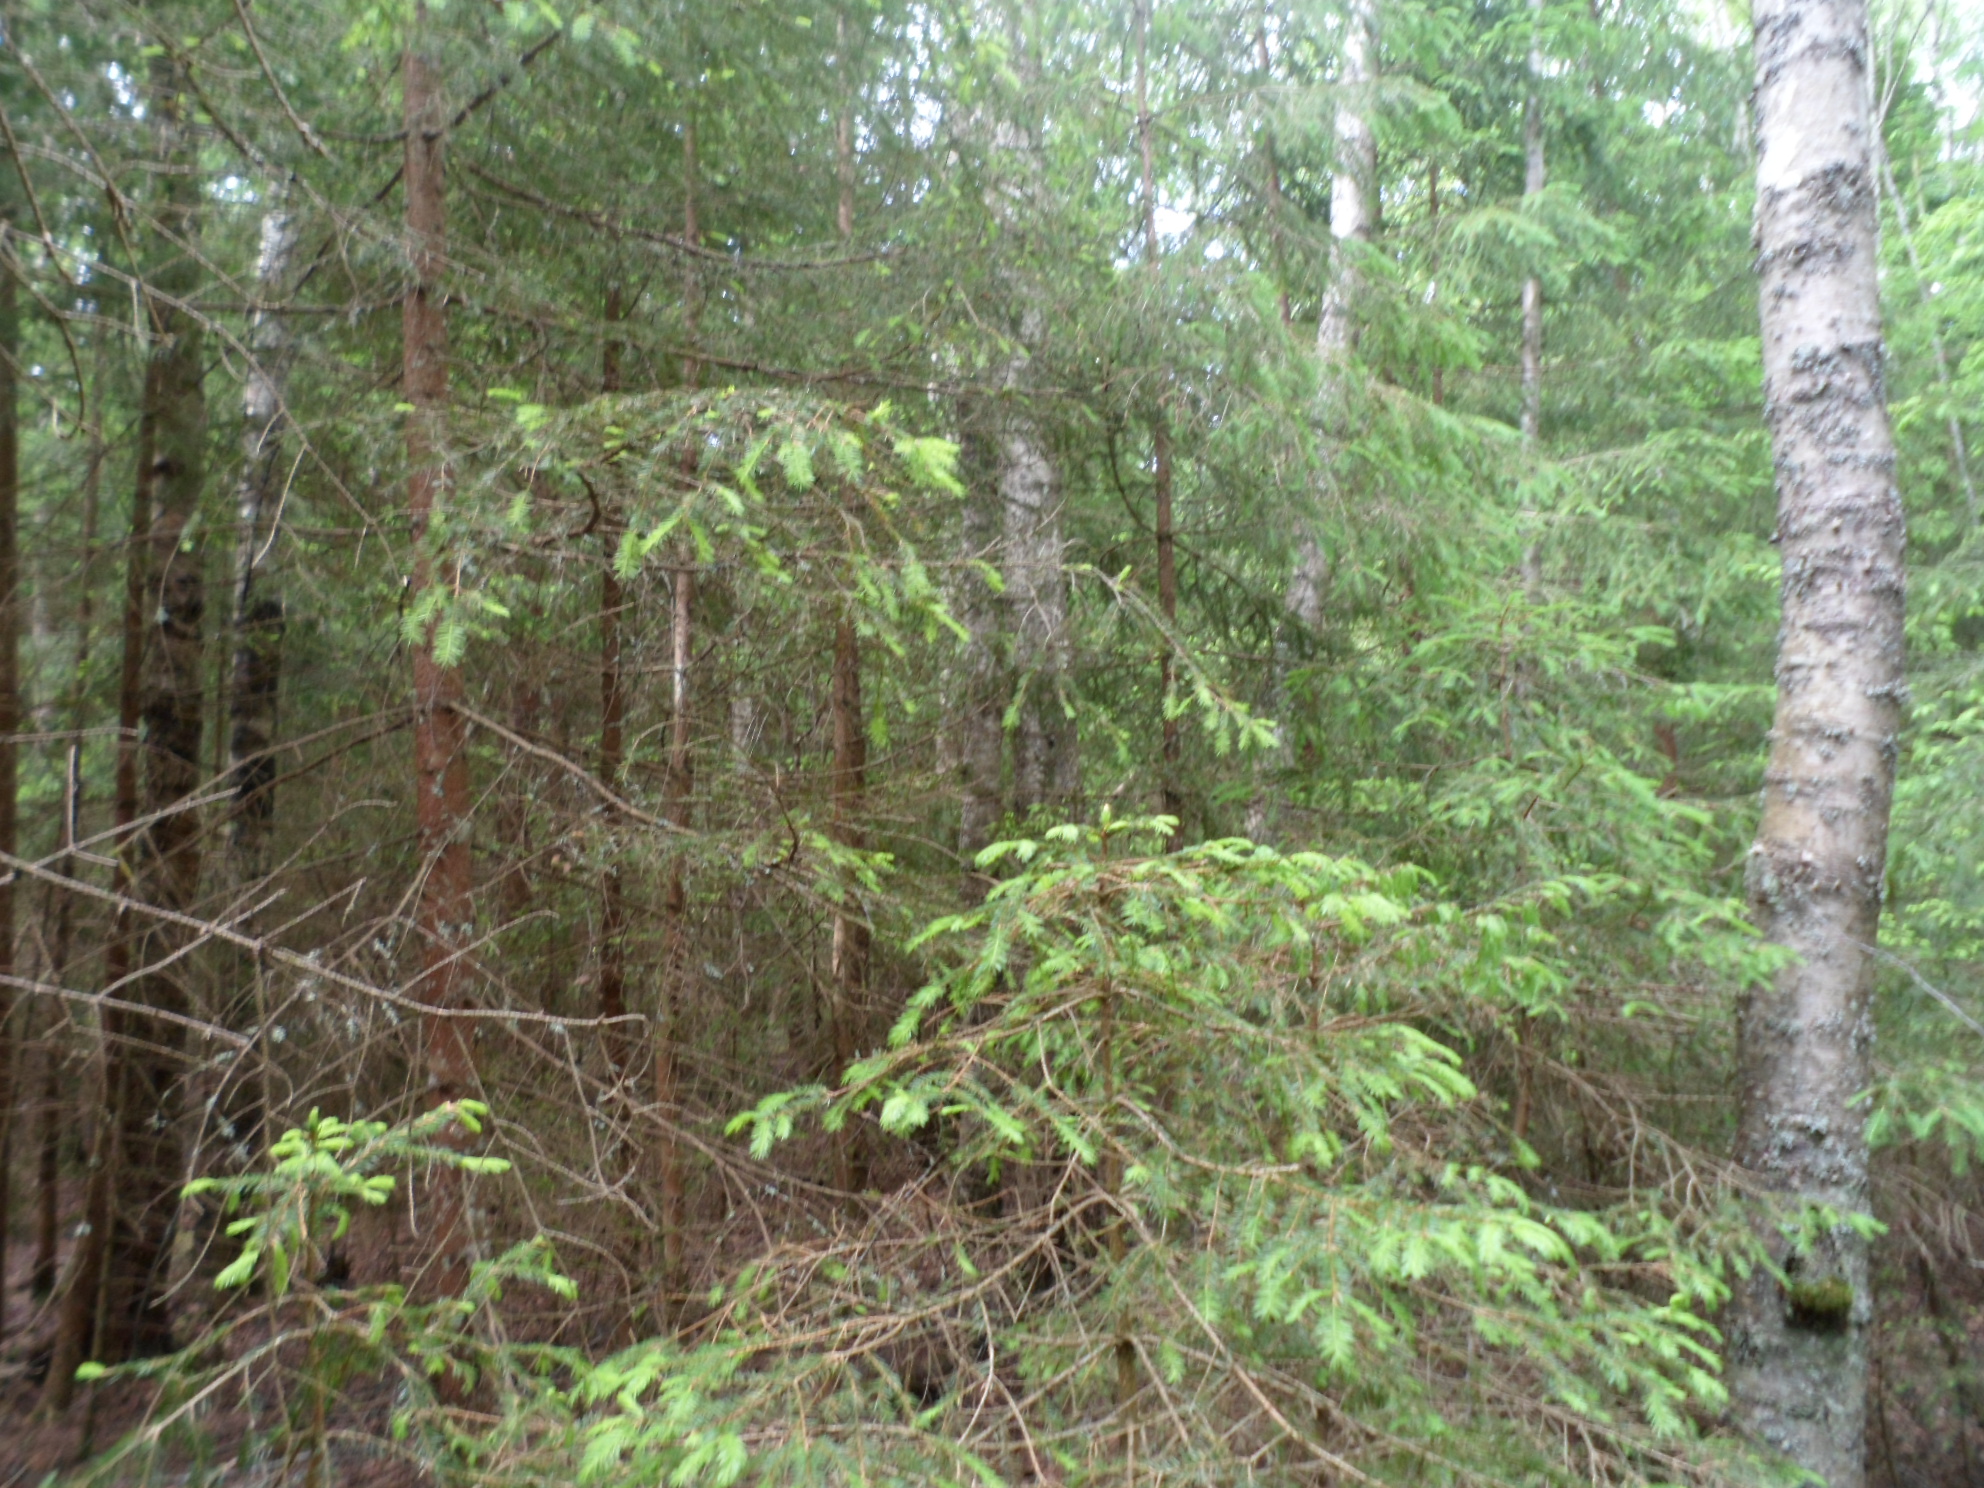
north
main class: Woodland
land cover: Spruce dominated mixed woodland
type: boreal forest
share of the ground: 50 - 75 %
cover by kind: coniferous forest trees 45 %, broadleaved forest trees 20 %, lichens and mosses 15 %, consolidated bare surface 10 %, shrubs 5 %, herbaceous plants 5 %
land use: Forestry
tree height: > 5 m
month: June
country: SE
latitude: 56.9570
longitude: 15.4078
